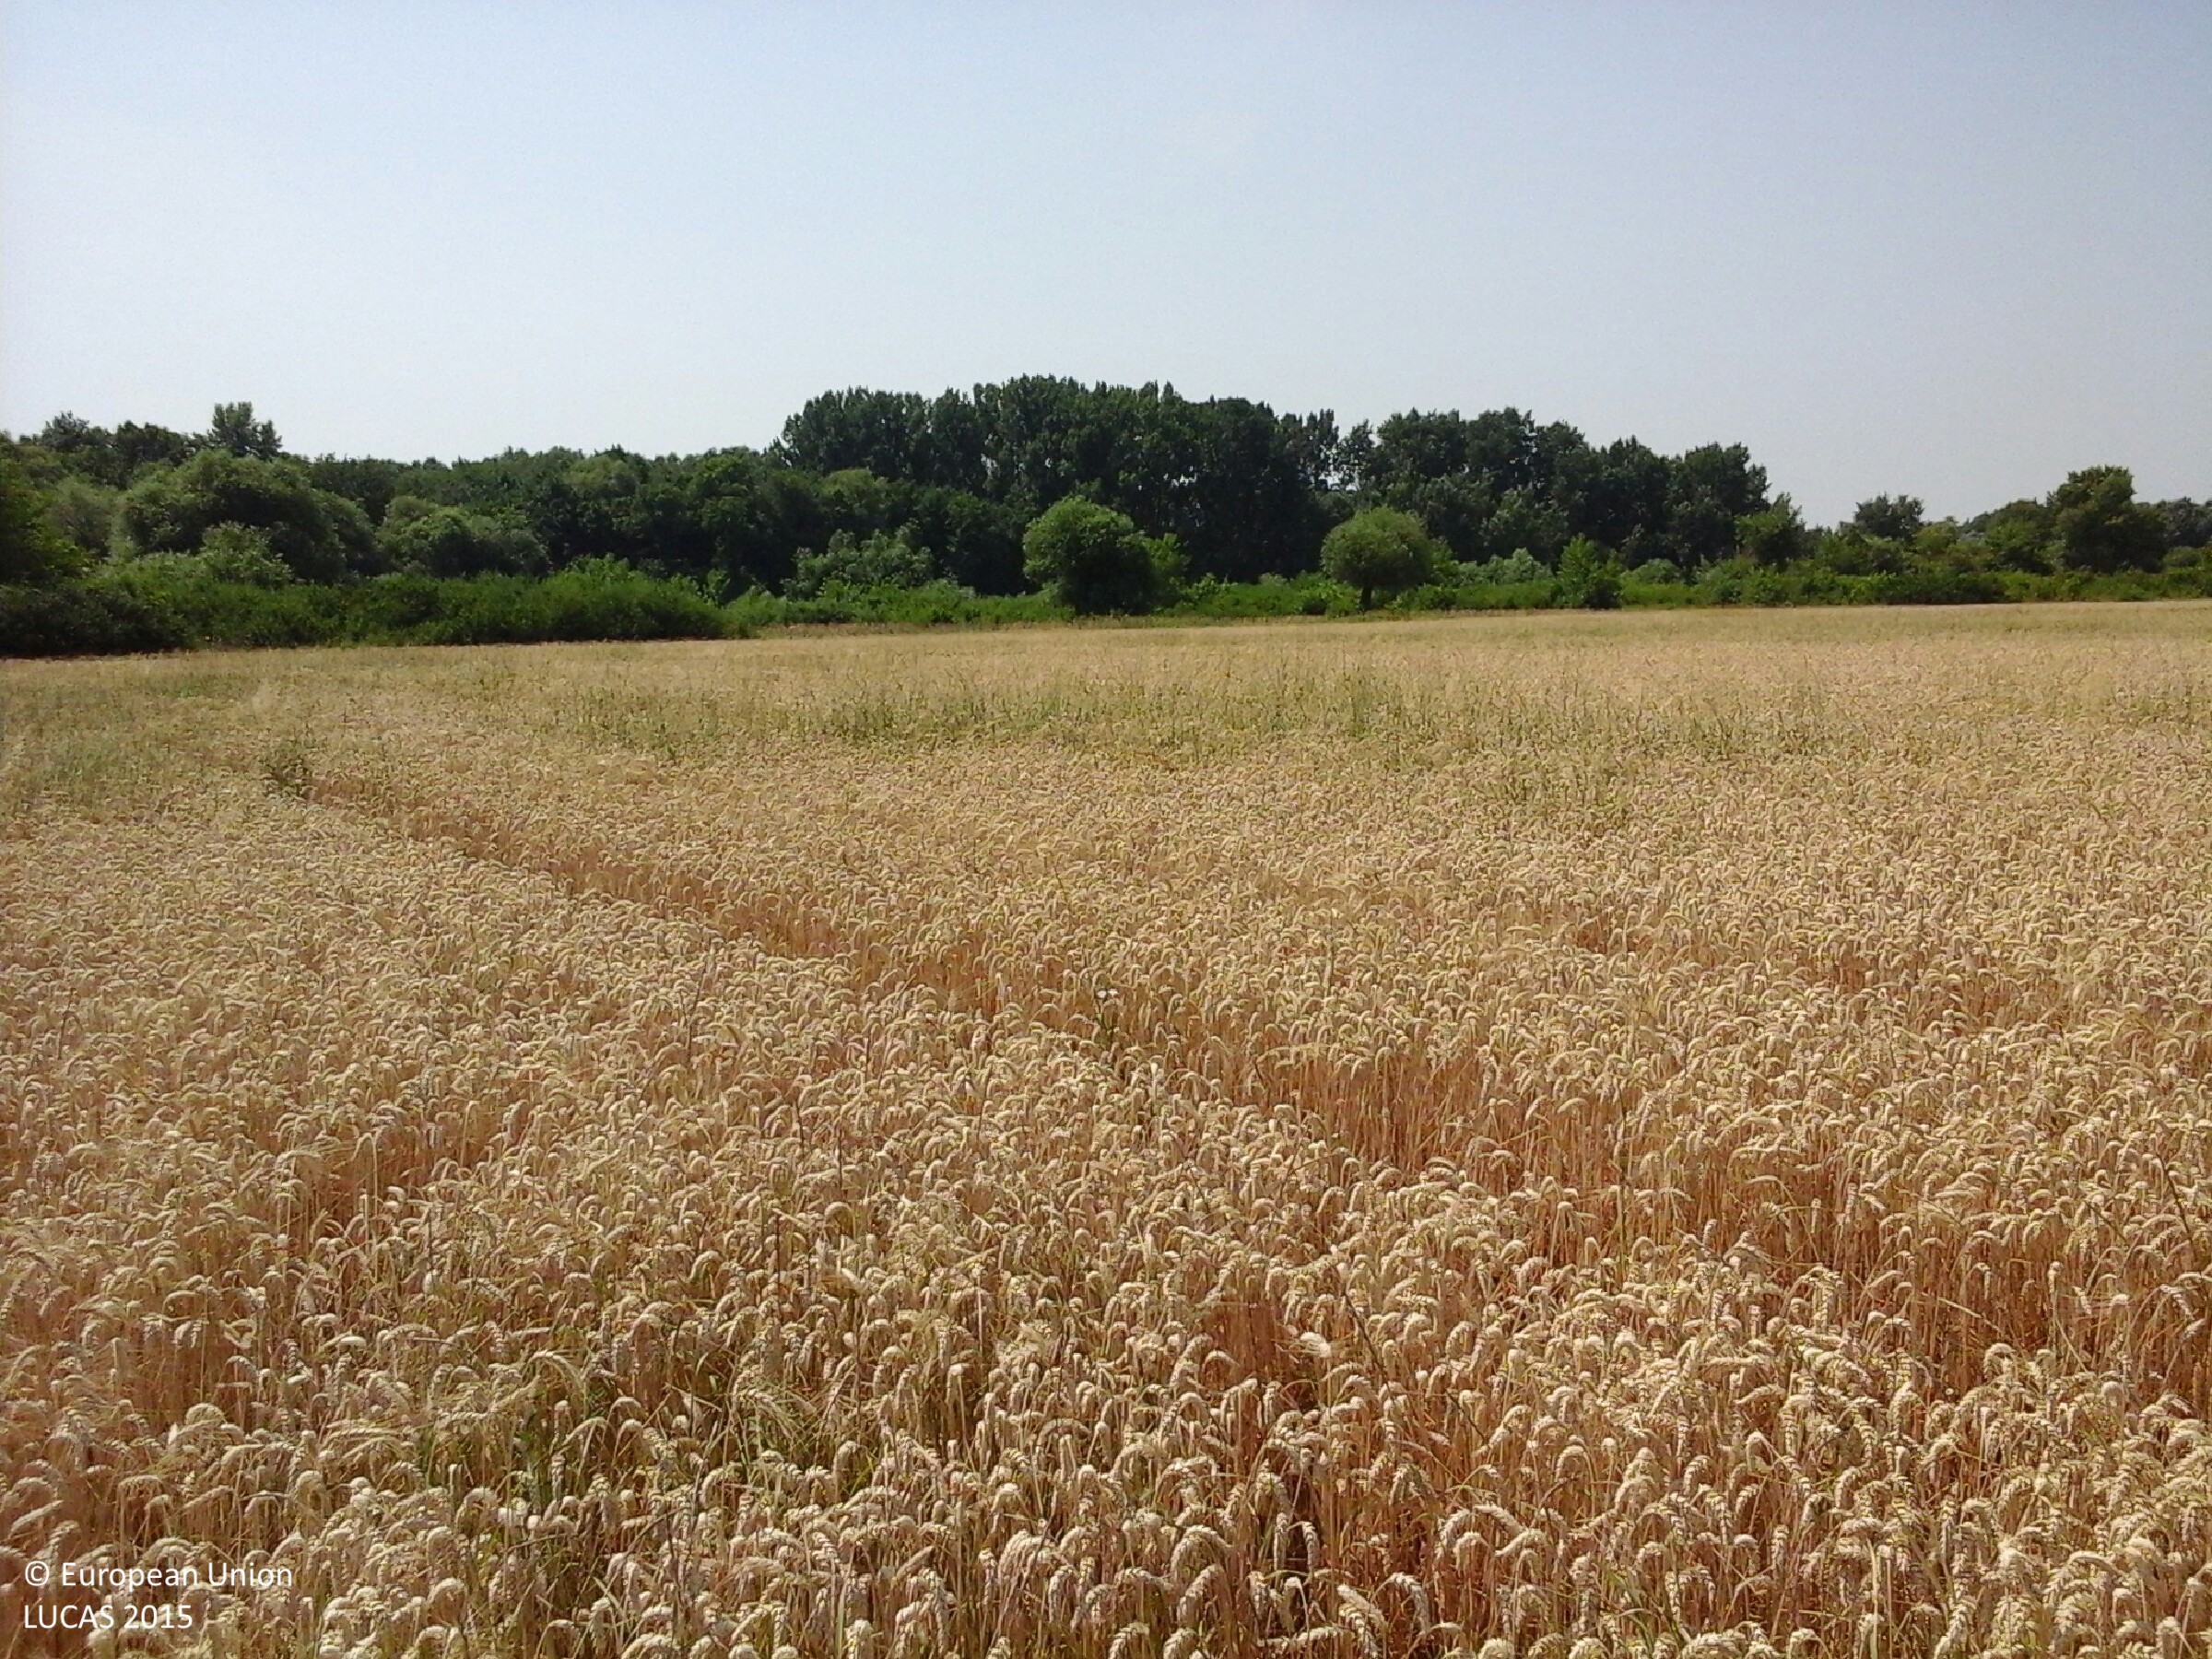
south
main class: Cropland
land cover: Common wheat
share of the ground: > 75 %
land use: Agriculture (excluding fallow land and kitchen gardens)
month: July
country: HU
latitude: 47.9611
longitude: 21.0072
